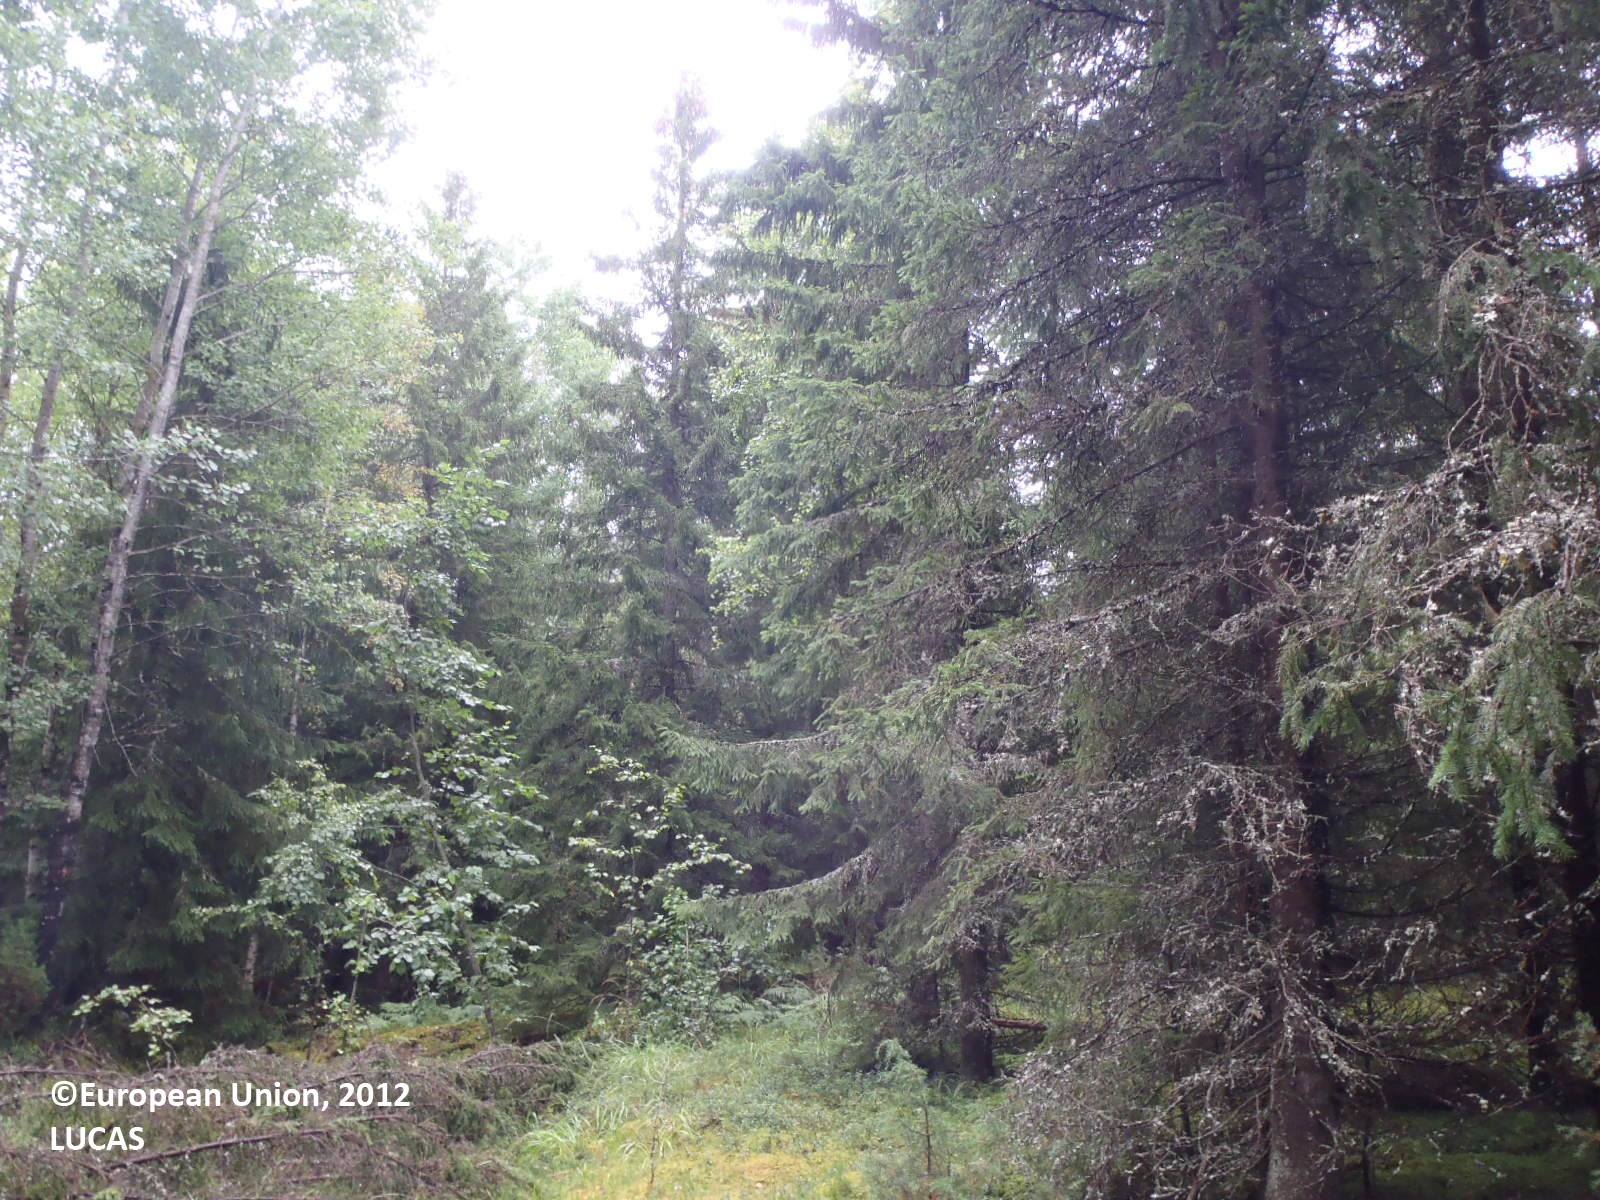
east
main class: Woodland
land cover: Spruce dominated coniferous woodland
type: boreal forest
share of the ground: > 75 %
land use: Forestry
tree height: > 5 m
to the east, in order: Spruce dominated coniferous woodland; Spruce dominated mixed woodland; Ditches and canals; Grass margins; Paved roads, cycling and walking lanes; Ditches and canals; Spruce dominated mixed woodland; Artificial constructions in urban areas; Pine dominated coniferous woodland; Spruce dominated coniferous woodland; Pine dominated coniferous woodland
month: August
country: FI
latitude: 60.7271
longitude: 22.1828
